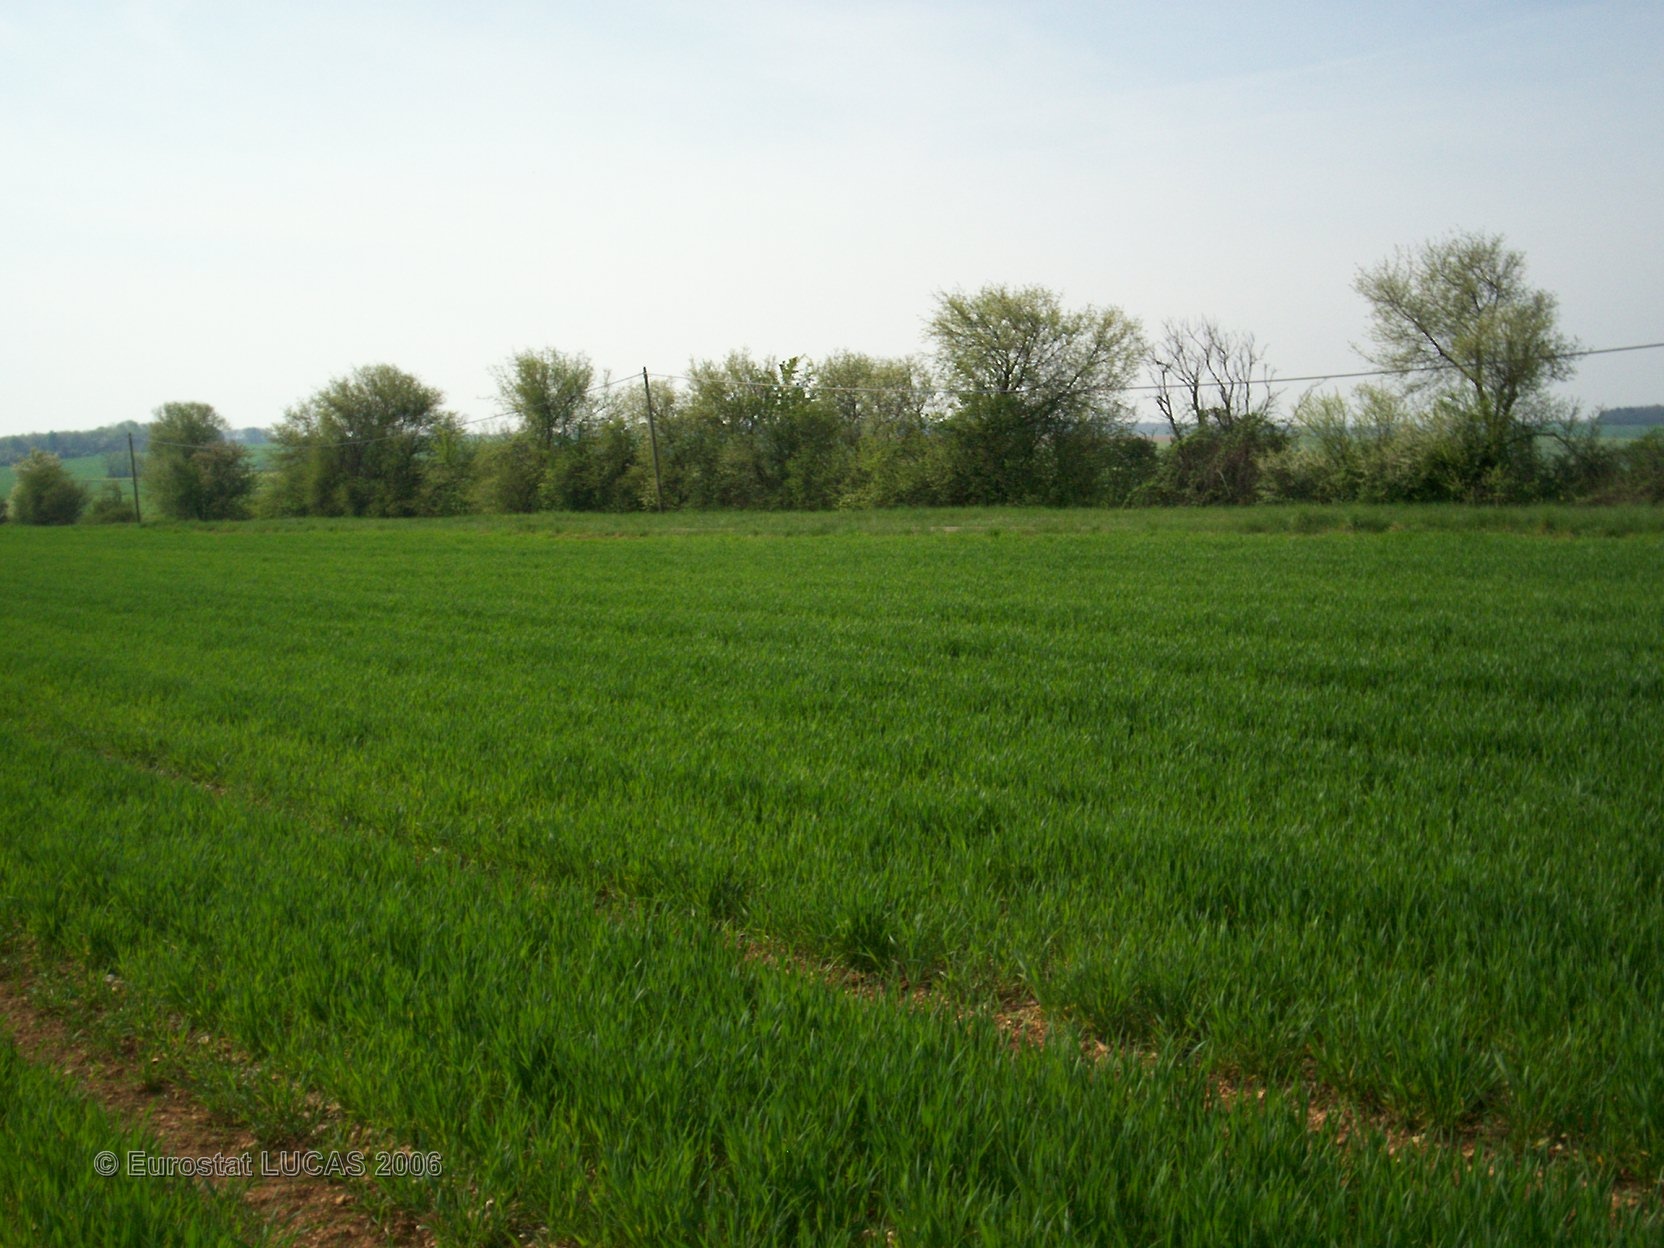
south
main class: Cropland
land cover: Common wheat
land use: Agriculture (excluding fallow land and kitchen gardens)
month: May
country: FR
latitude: 47.6061
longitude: 4.6385
